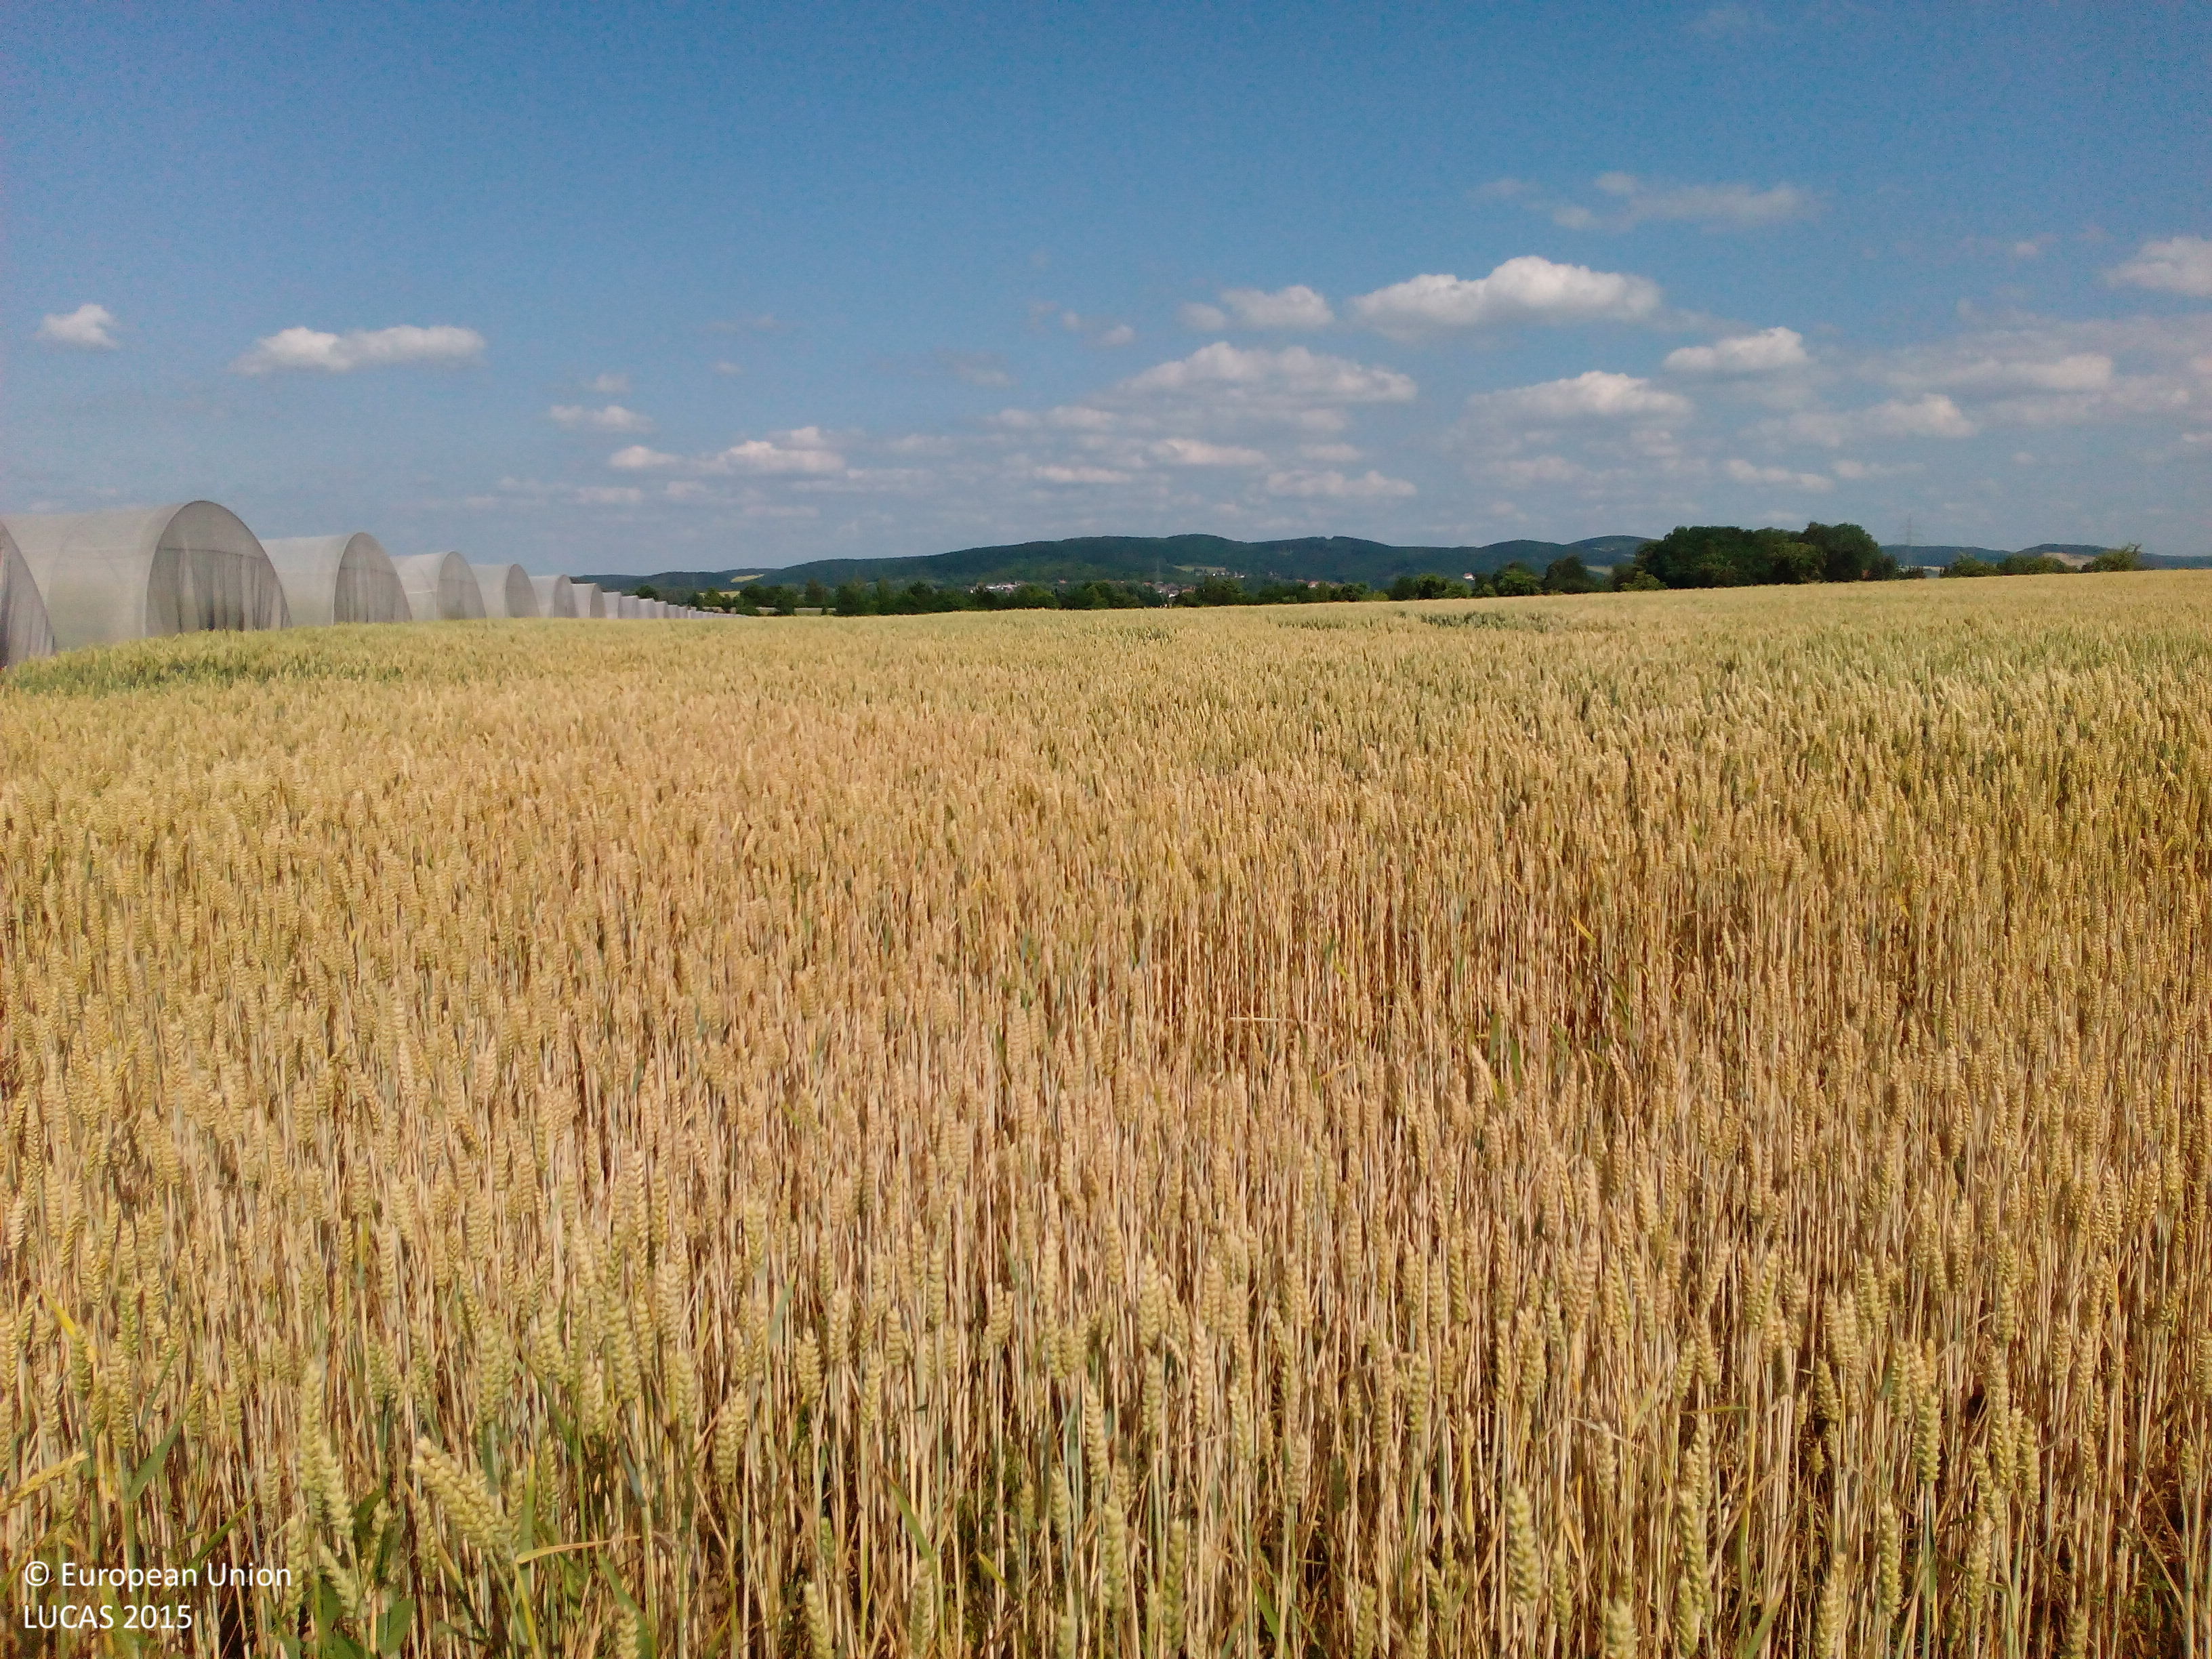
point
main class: Cropland
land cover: Common wheat
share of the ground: > 75 %
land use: Agriculture (excluding fallow land and kitchen gardens)
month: July
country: DE
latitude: 51.8022
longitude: 9.8695
